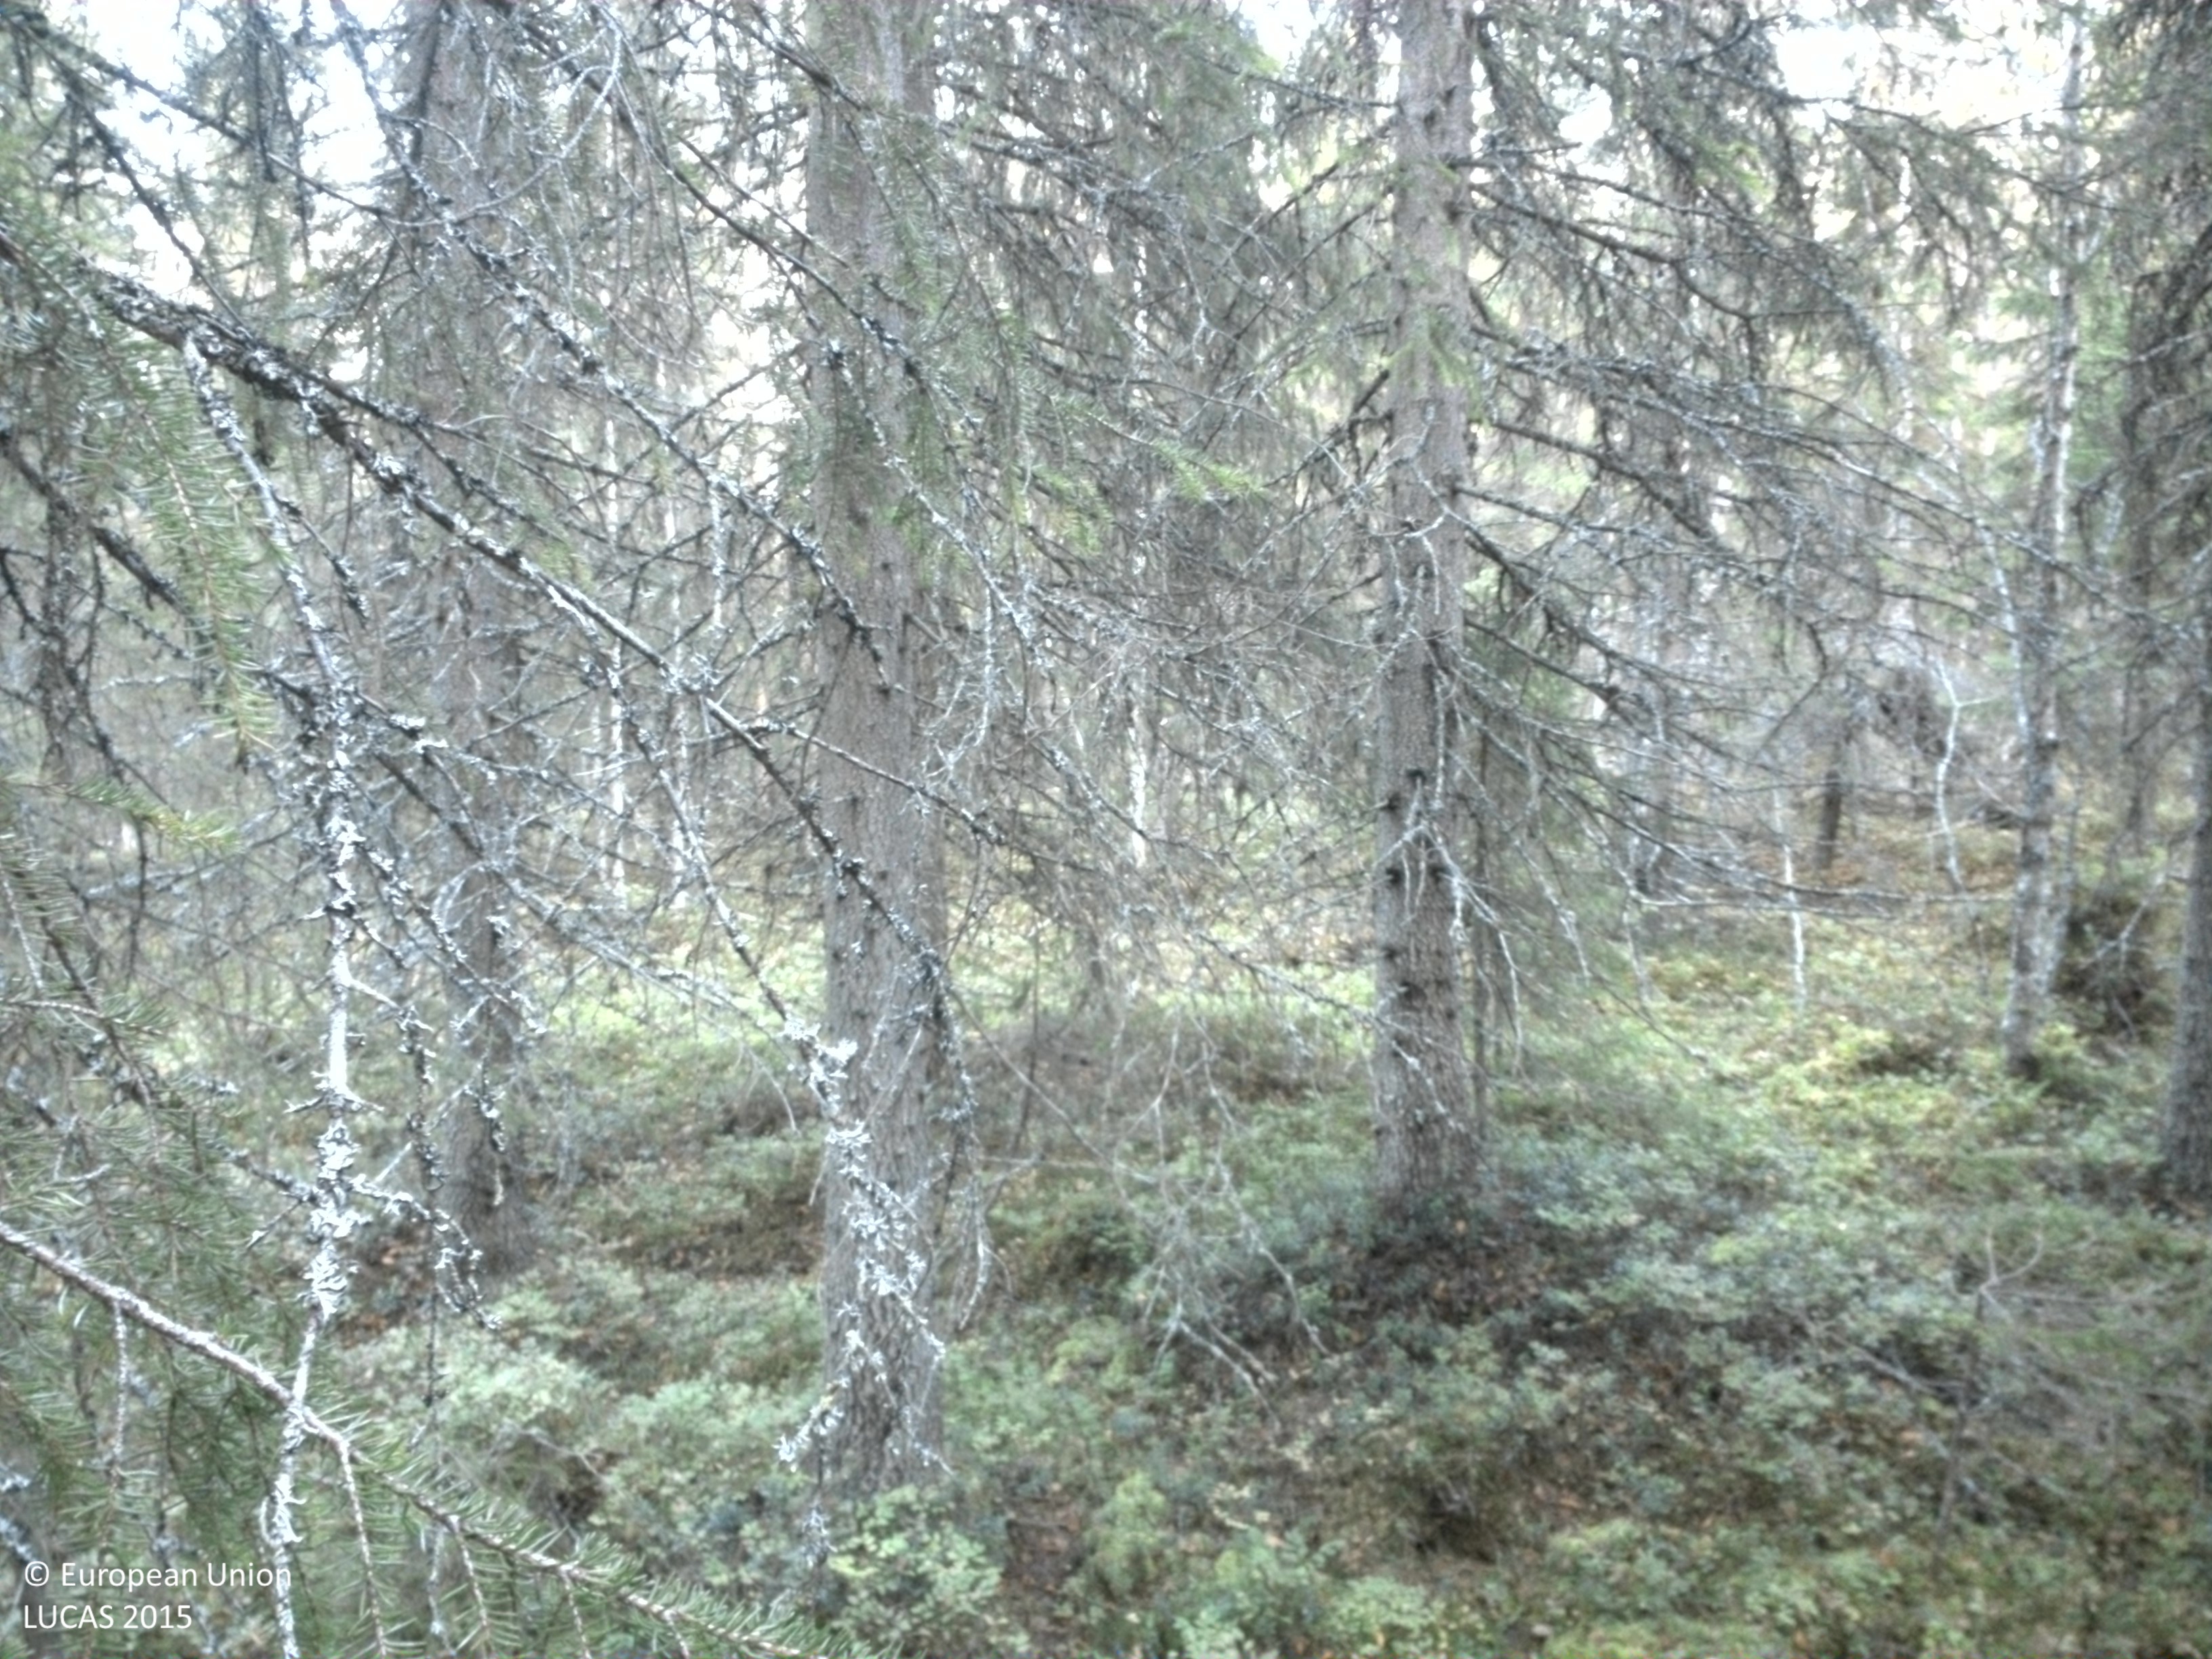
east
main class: Woodland
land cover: Spruce dominated coniferous woodland
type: boreal forest
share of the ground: 50 - 75 %
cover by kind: coniferous forest trees 45 %, shrubs 25 %, lichens and mosses 20 %, broadleaved forest trees 10 %
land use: Forestry
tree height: > 5 m
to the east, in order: Spruce dominated coniferous woodland; Ditches and canals; Tracks; Ditches and canals; Spruce dominated coniferous woodland; Rivers and streams; Spruce dominated mixed woodland; Spruce dominated coniferous woodland
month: October
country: SE
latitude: 64.8026
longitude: 17.4804
